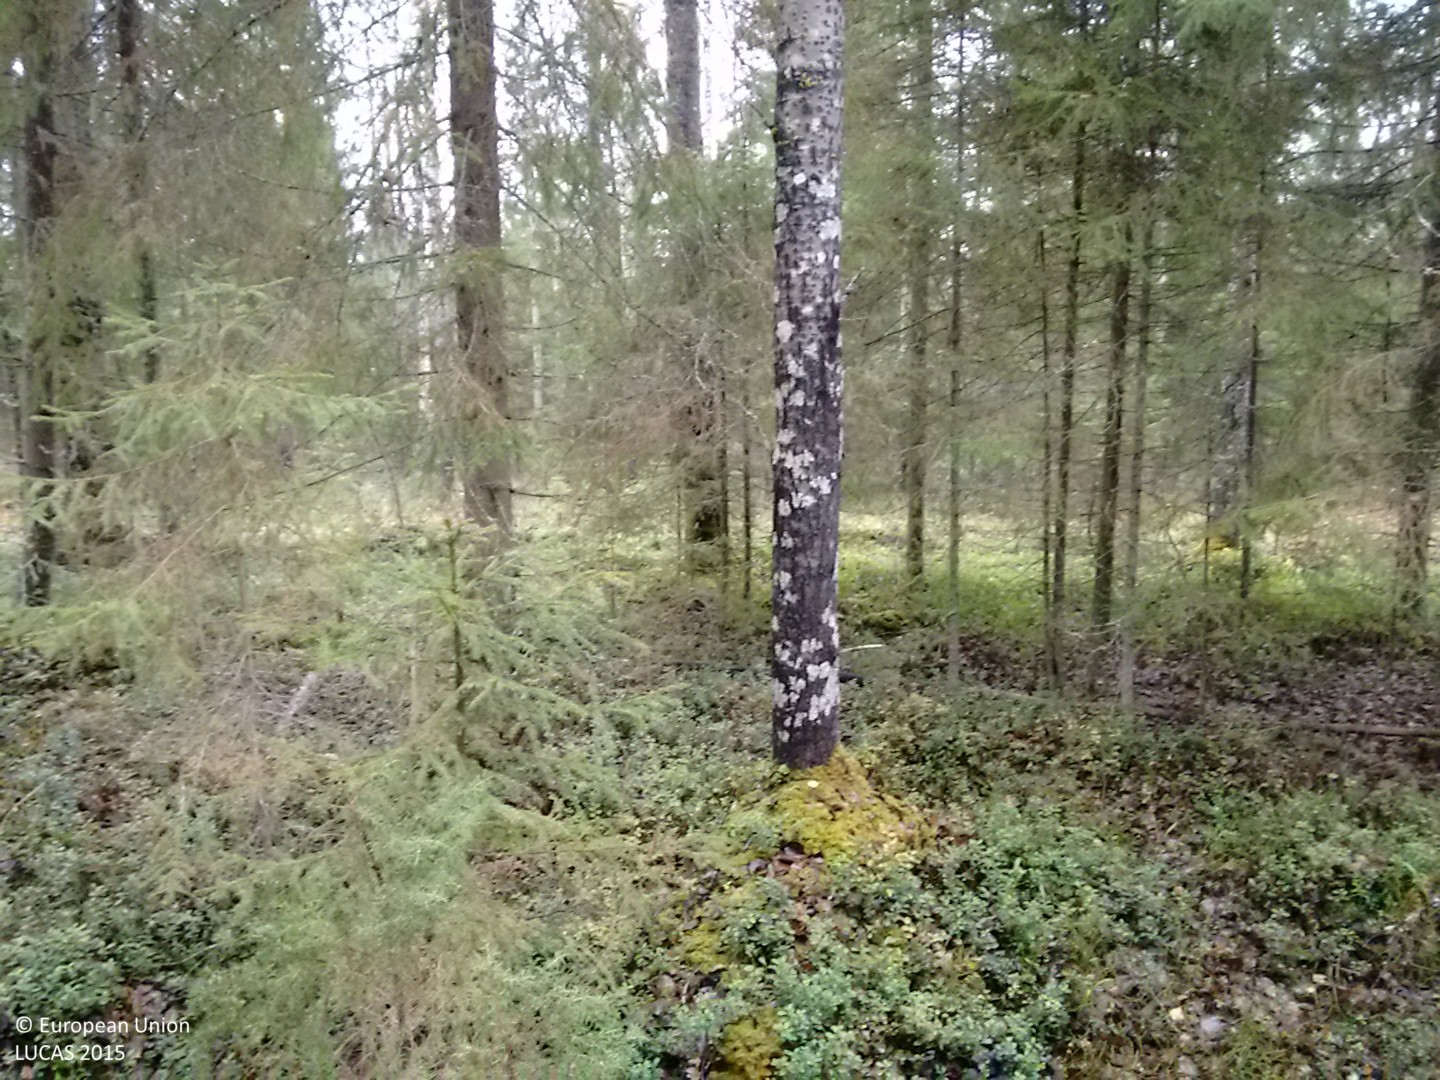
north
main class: Woodland
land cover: Spruce dominated mixed woodland
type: boreal forest
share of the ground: > 75 %
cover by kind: coniferous forest trees 60 %, broadleaved forest trees 25 %, shrubs 15 %
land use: Forestry
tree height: > 5 m
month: October
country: FI
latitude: 64.4722
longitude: 25.2034
